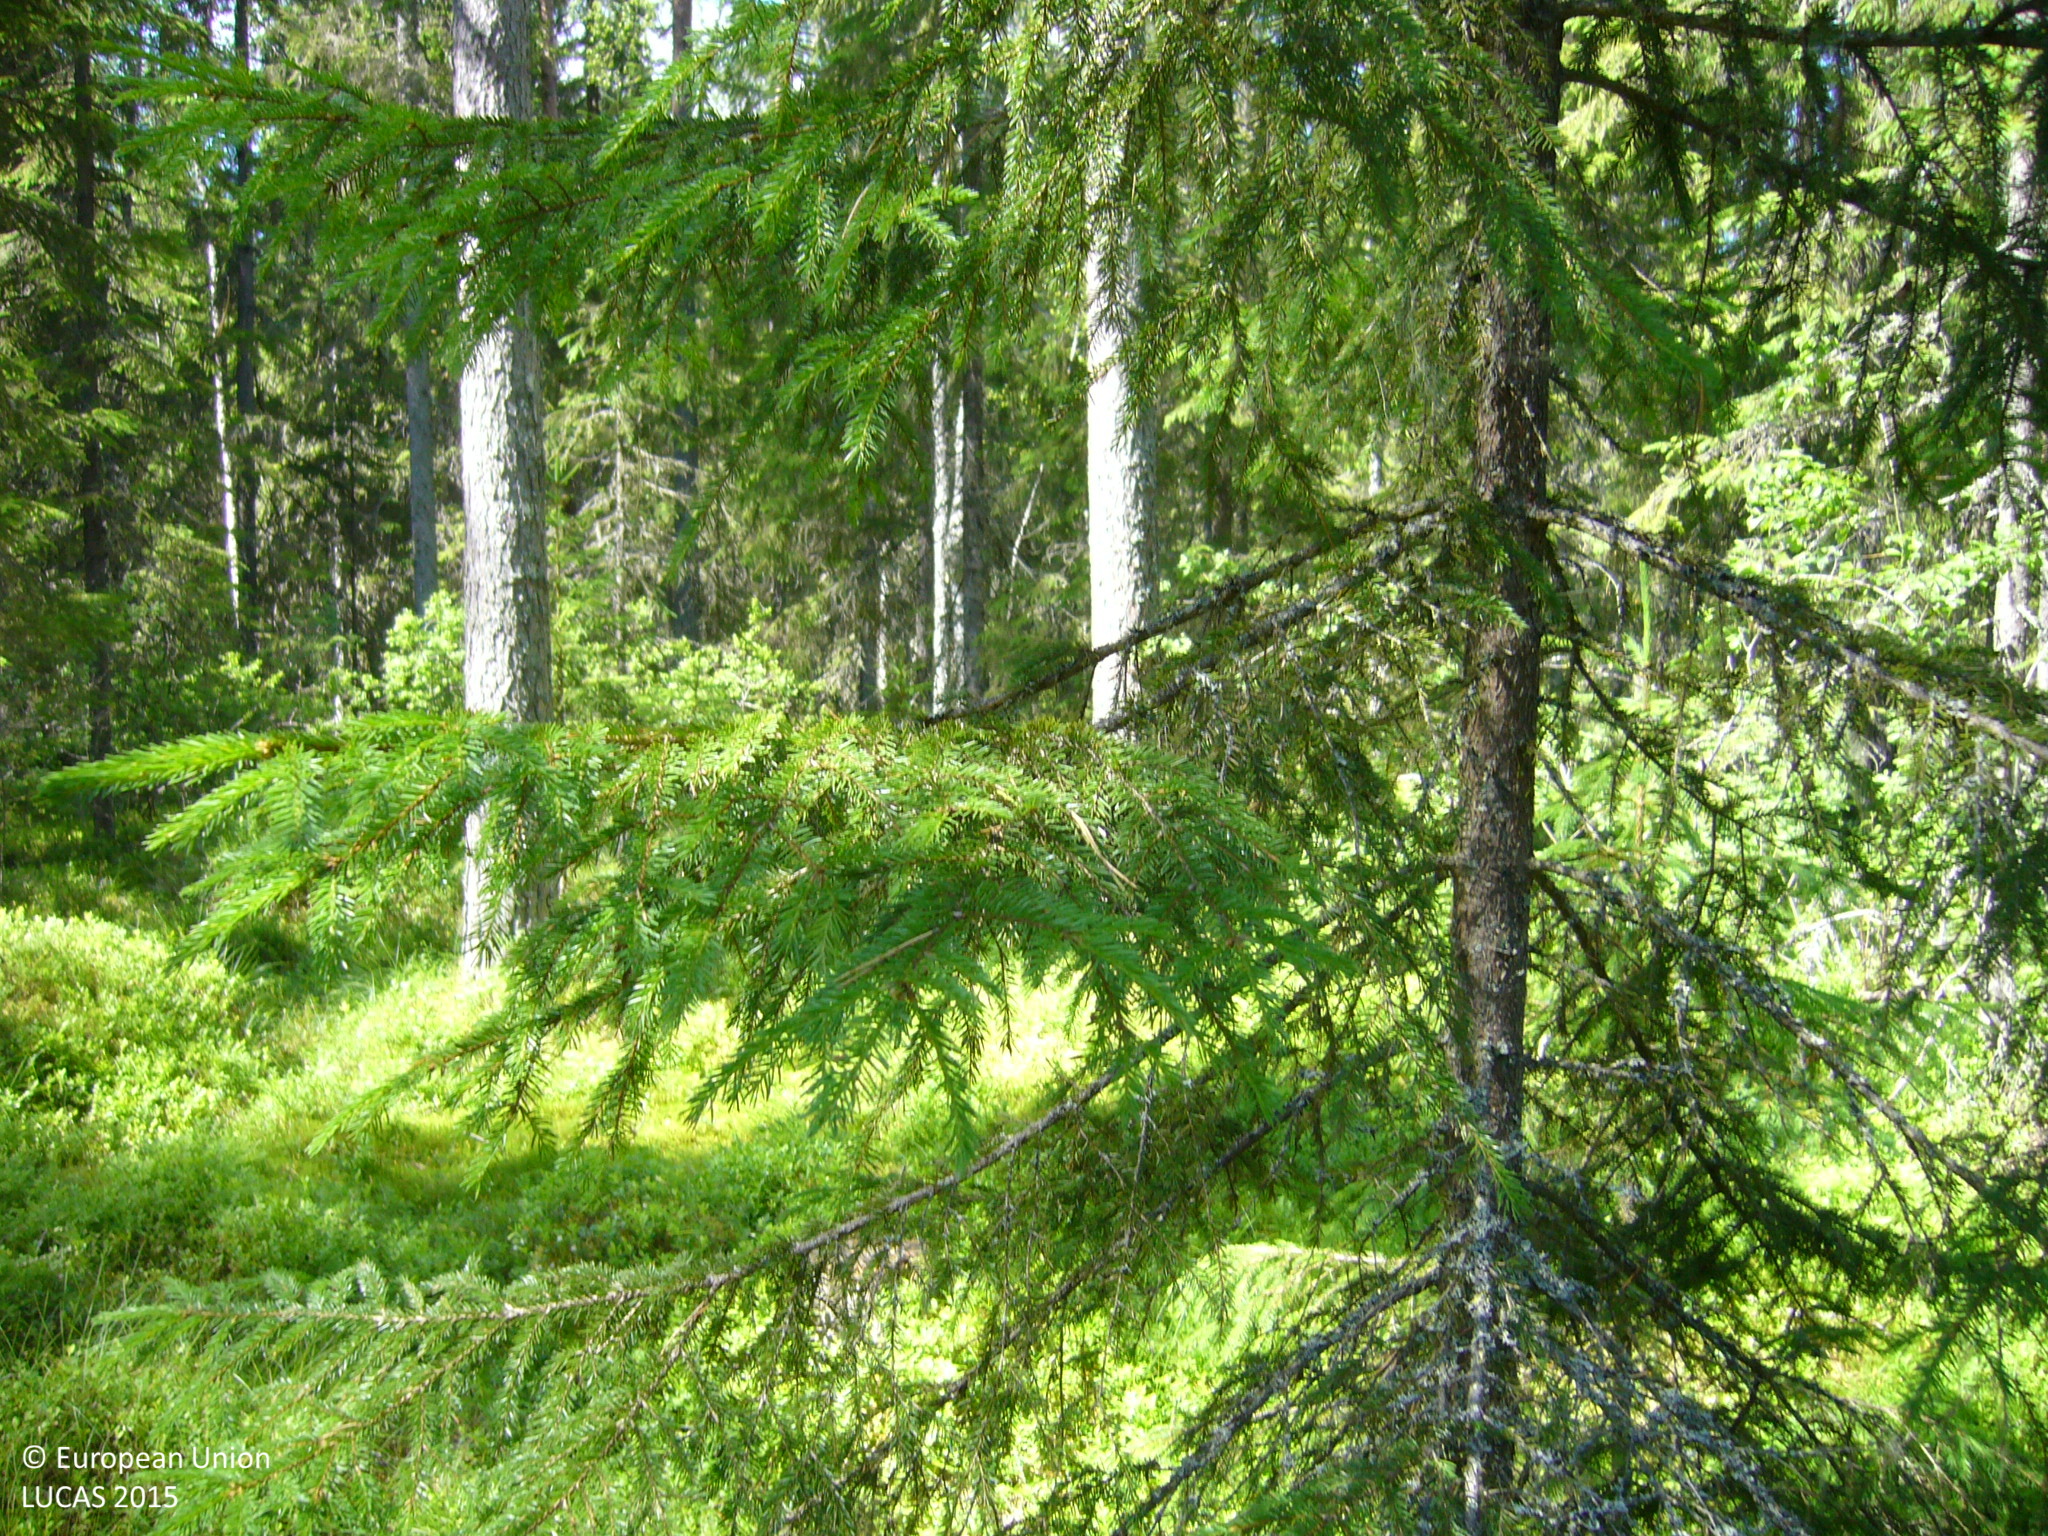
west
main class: Woodland
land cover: Spruce dominated coniferous woodland
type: boreal forest
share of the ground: 50 - 75 %
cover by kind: coniferous forest trees 50 %, shrubs 40 %, broadleaved forest trees 10 %
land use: Forestry
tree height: > 5 m
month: July
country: FI
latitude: 63.3094
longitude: 26.2662
